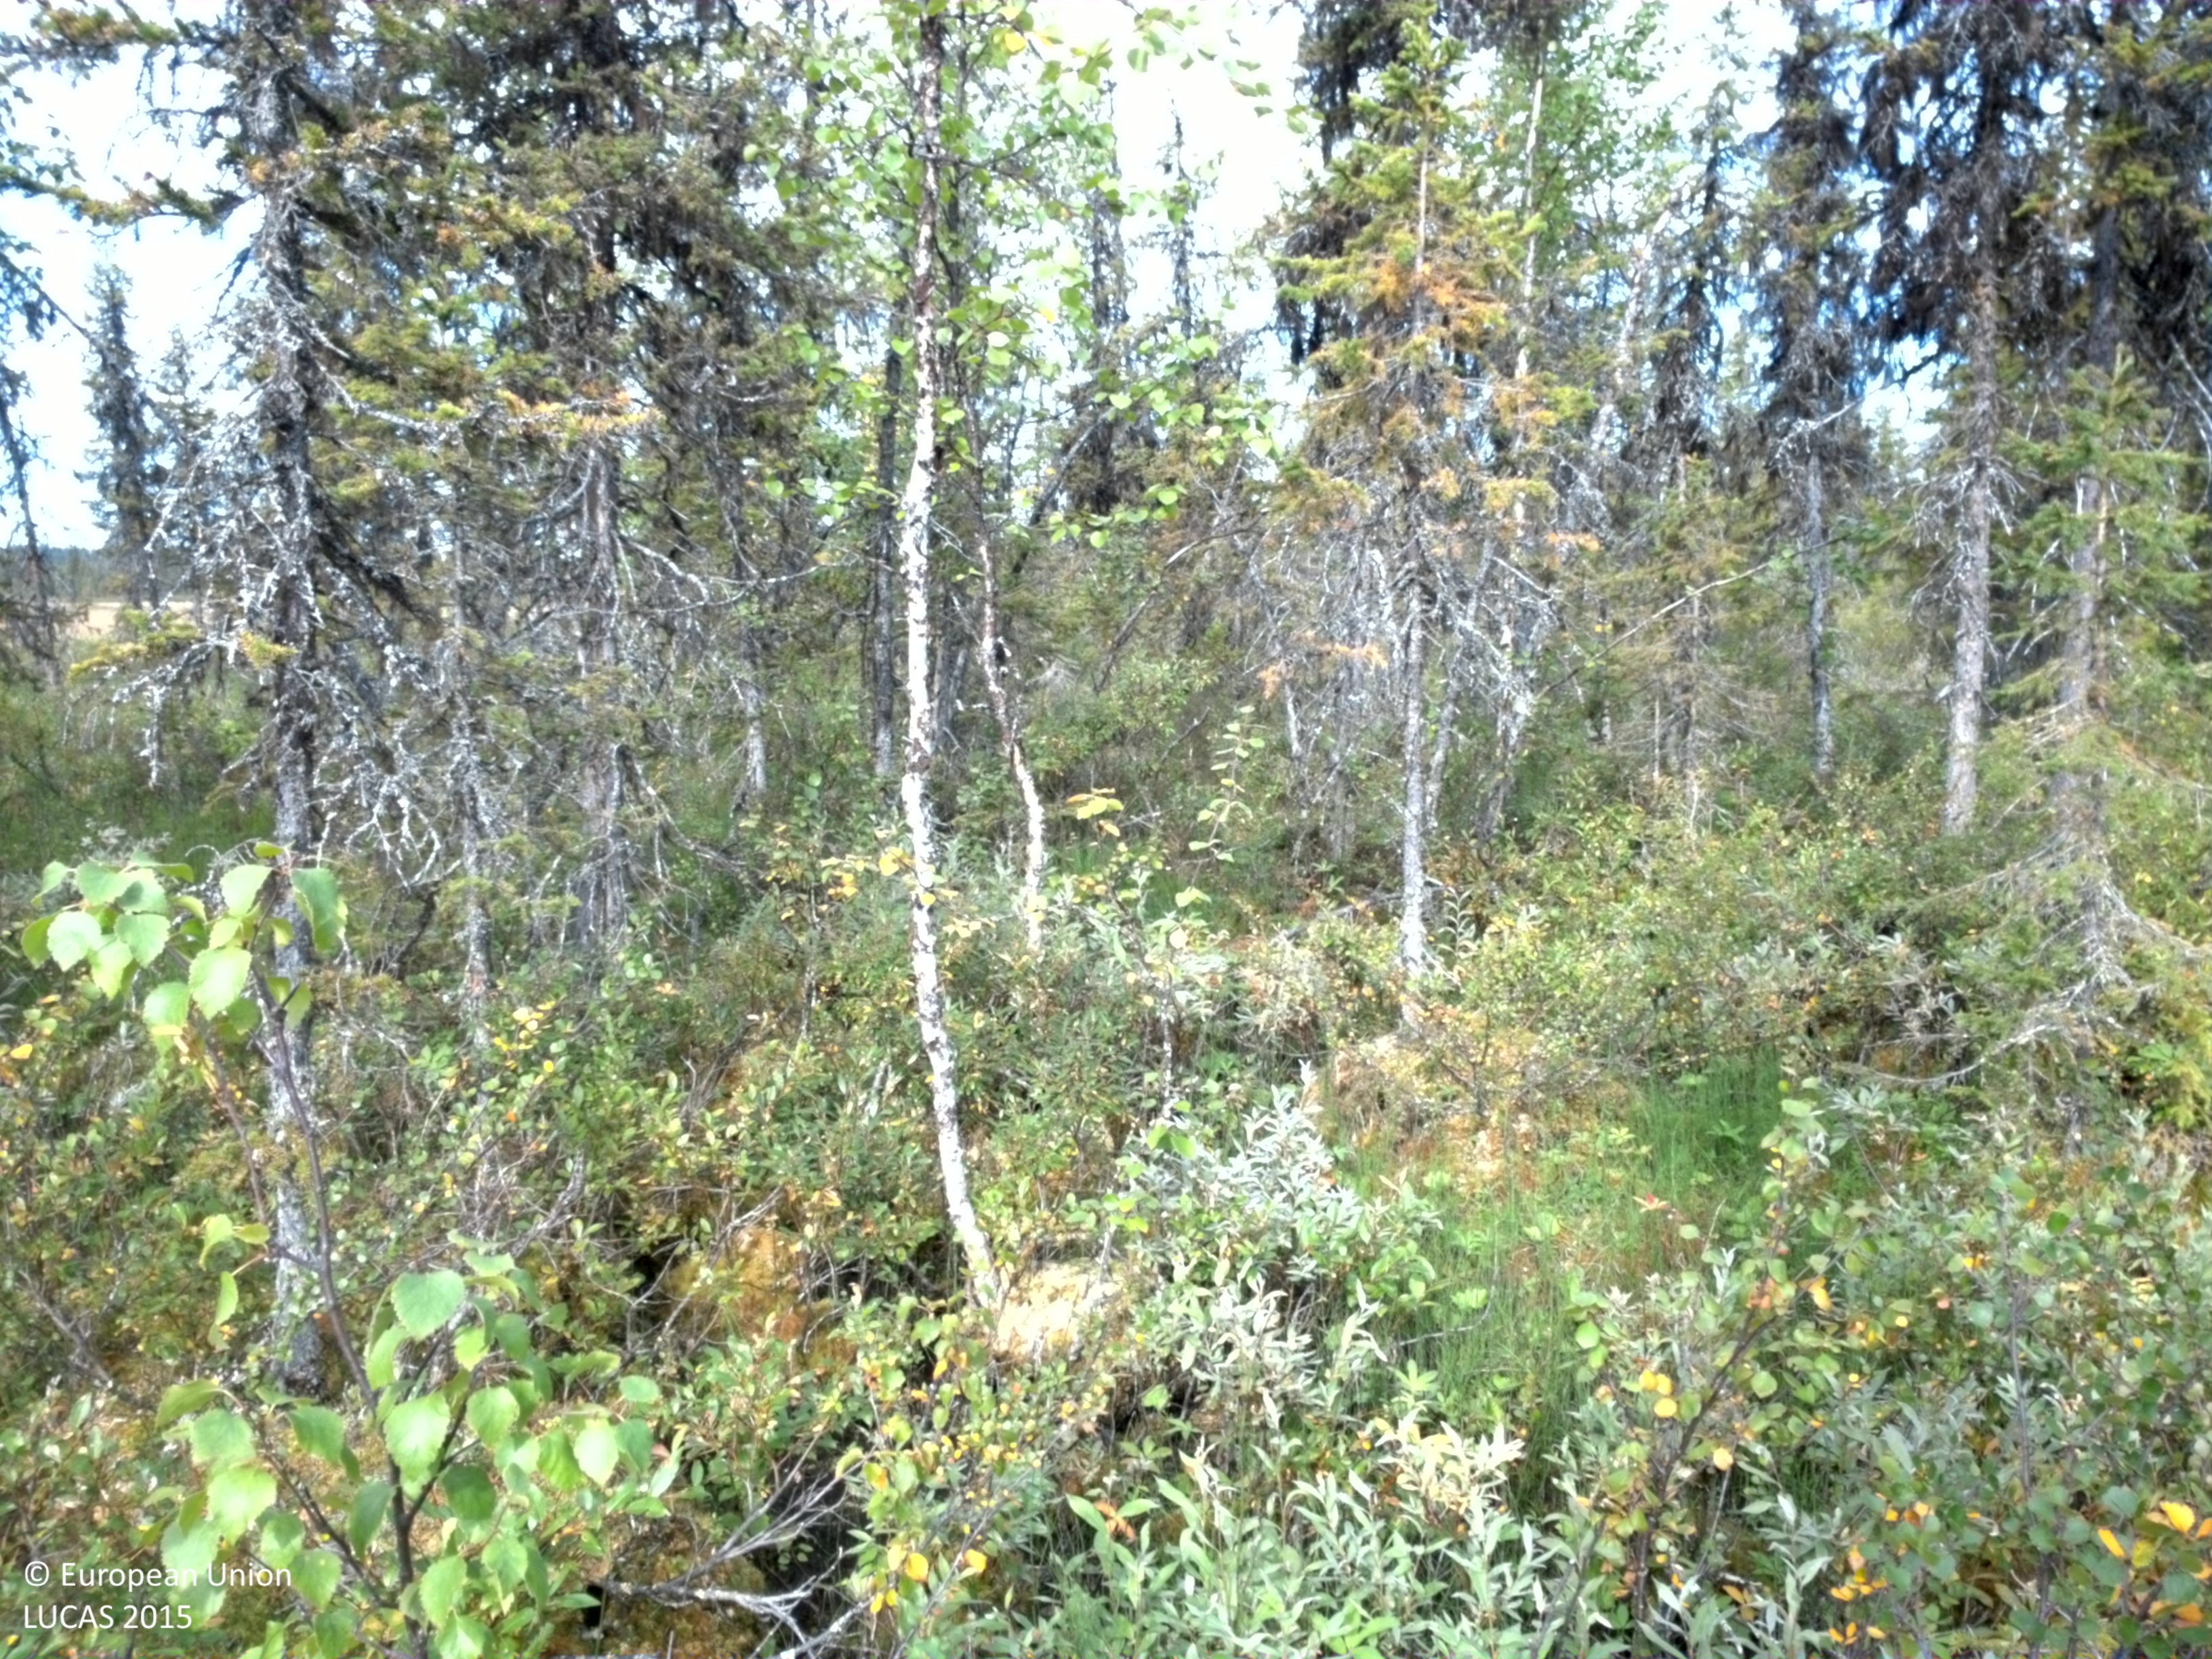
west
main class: Woodland
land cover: Spruce dominated coniferous woodland
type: boreal forest
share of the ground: 25 - 50 %
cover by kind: shrubs 60 %, coniferous forest trees 30 %, herbaceous plants 5 %, lichens and mosses 5 %
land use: Forestry
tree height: > 5 m
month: August
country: SE
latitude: 66.9012
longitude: 19.1987
